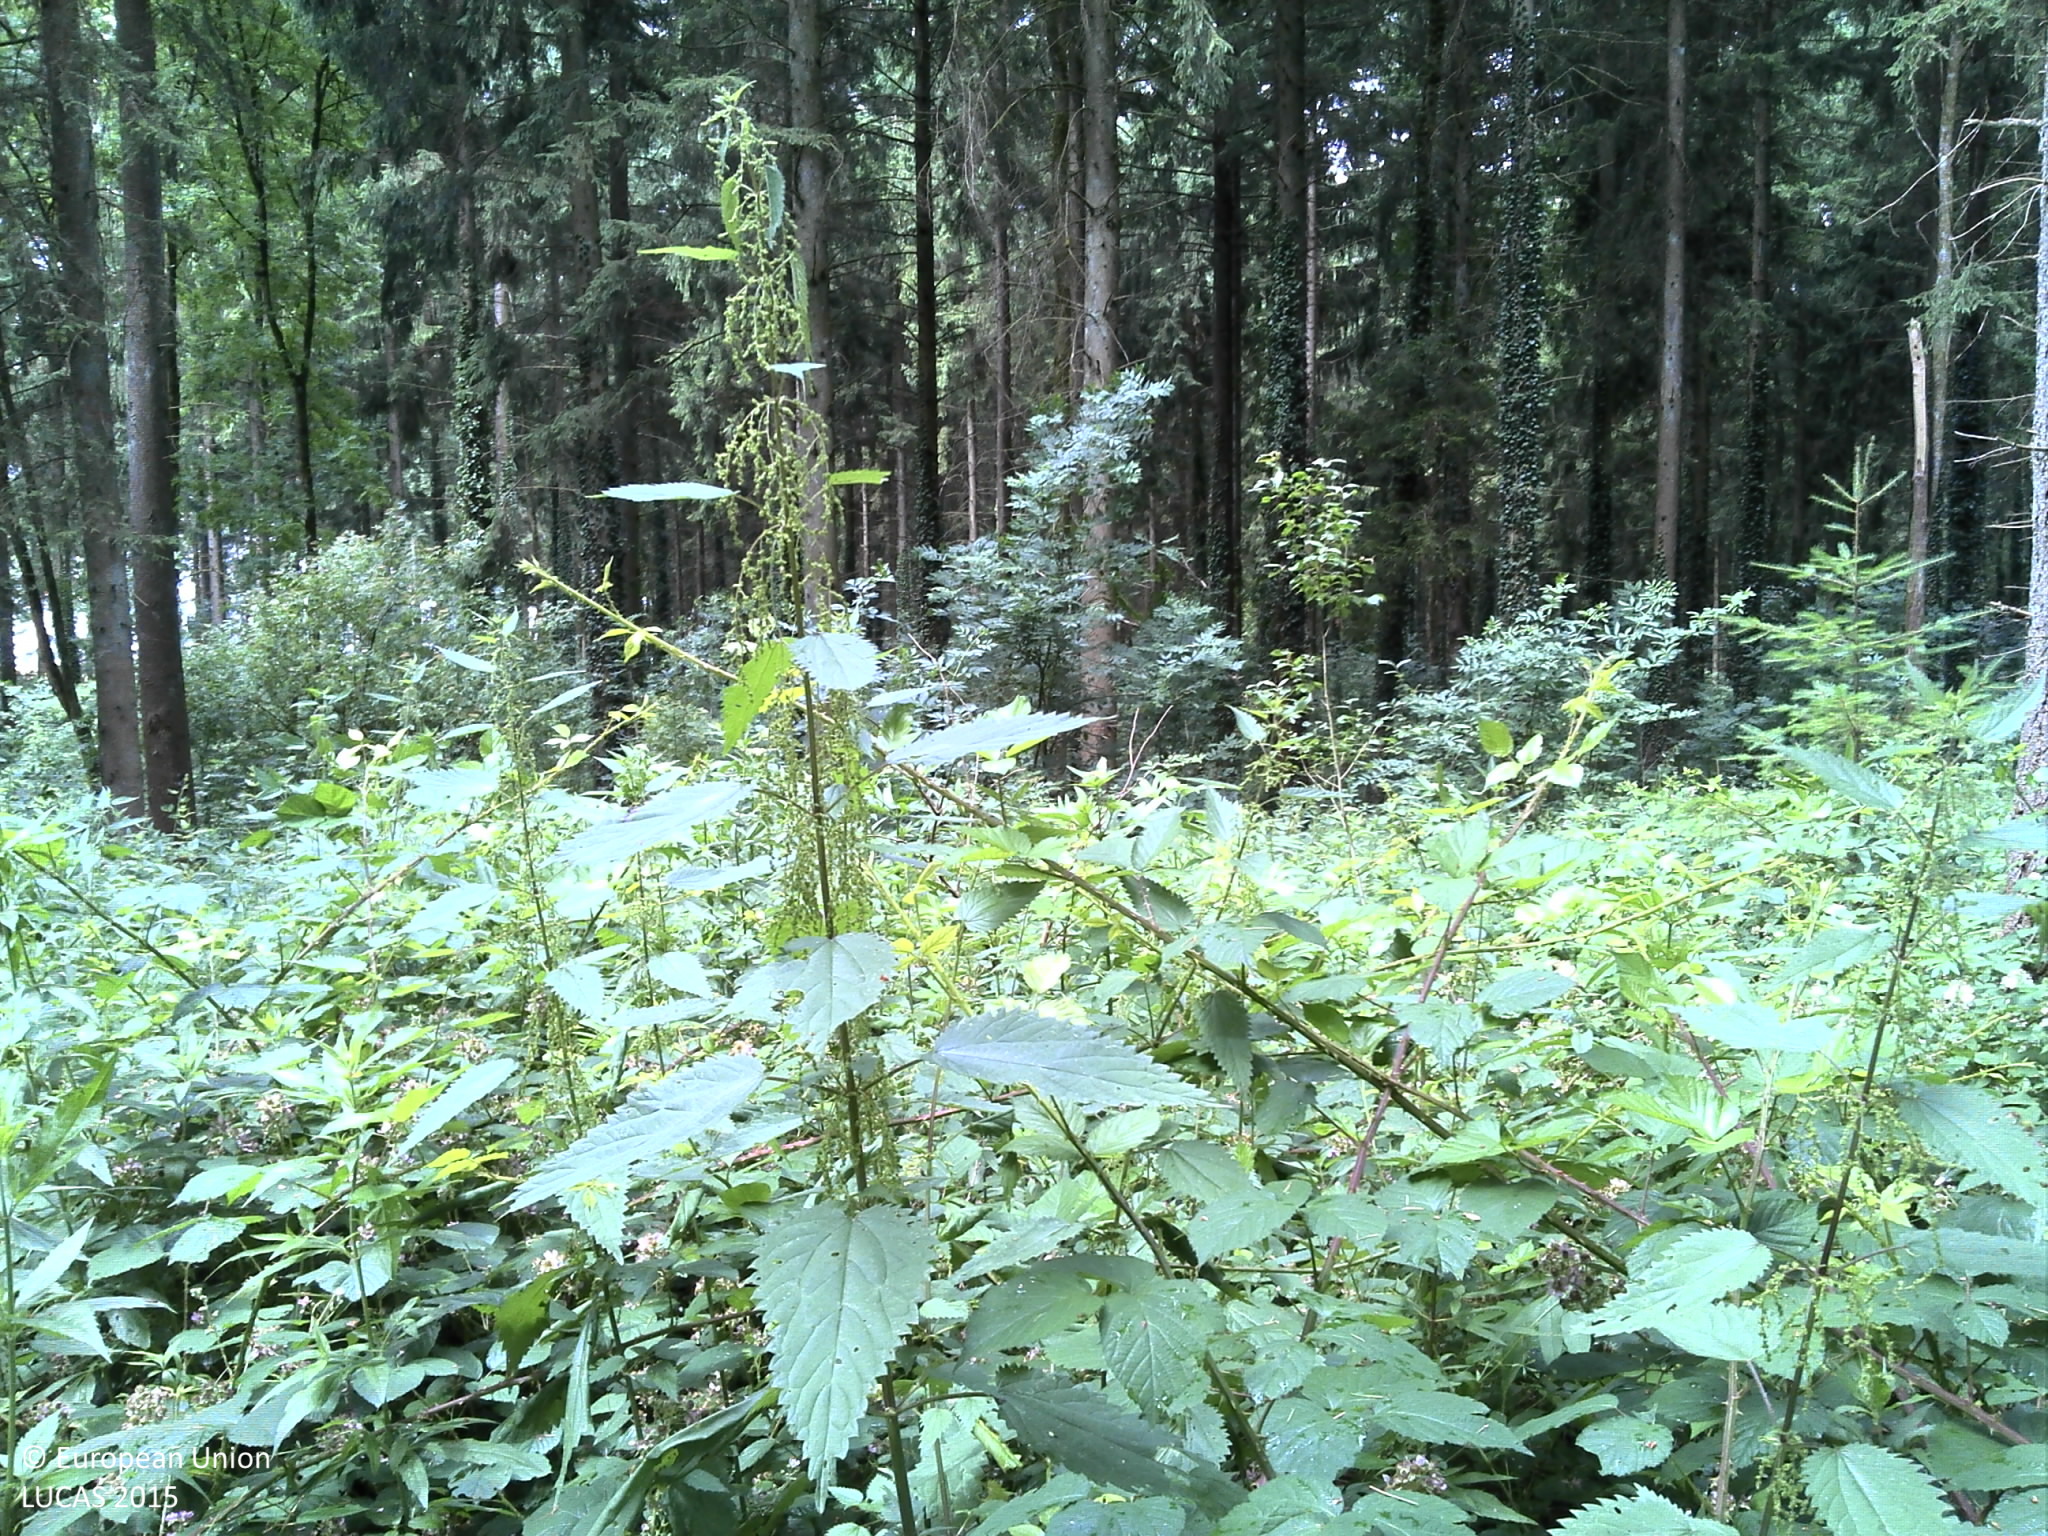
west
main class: Woodland
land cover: Spruce dominated coniferous woodland
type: exotic forest
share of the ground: > 75 %
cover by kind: coniferous forest trees 75 %, herbaceous plants 20 %, broadleaved forest trees 5 %
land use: Forestry
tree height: > 5 m
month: July
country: LU
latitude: 49.4493
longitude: 6.0406
